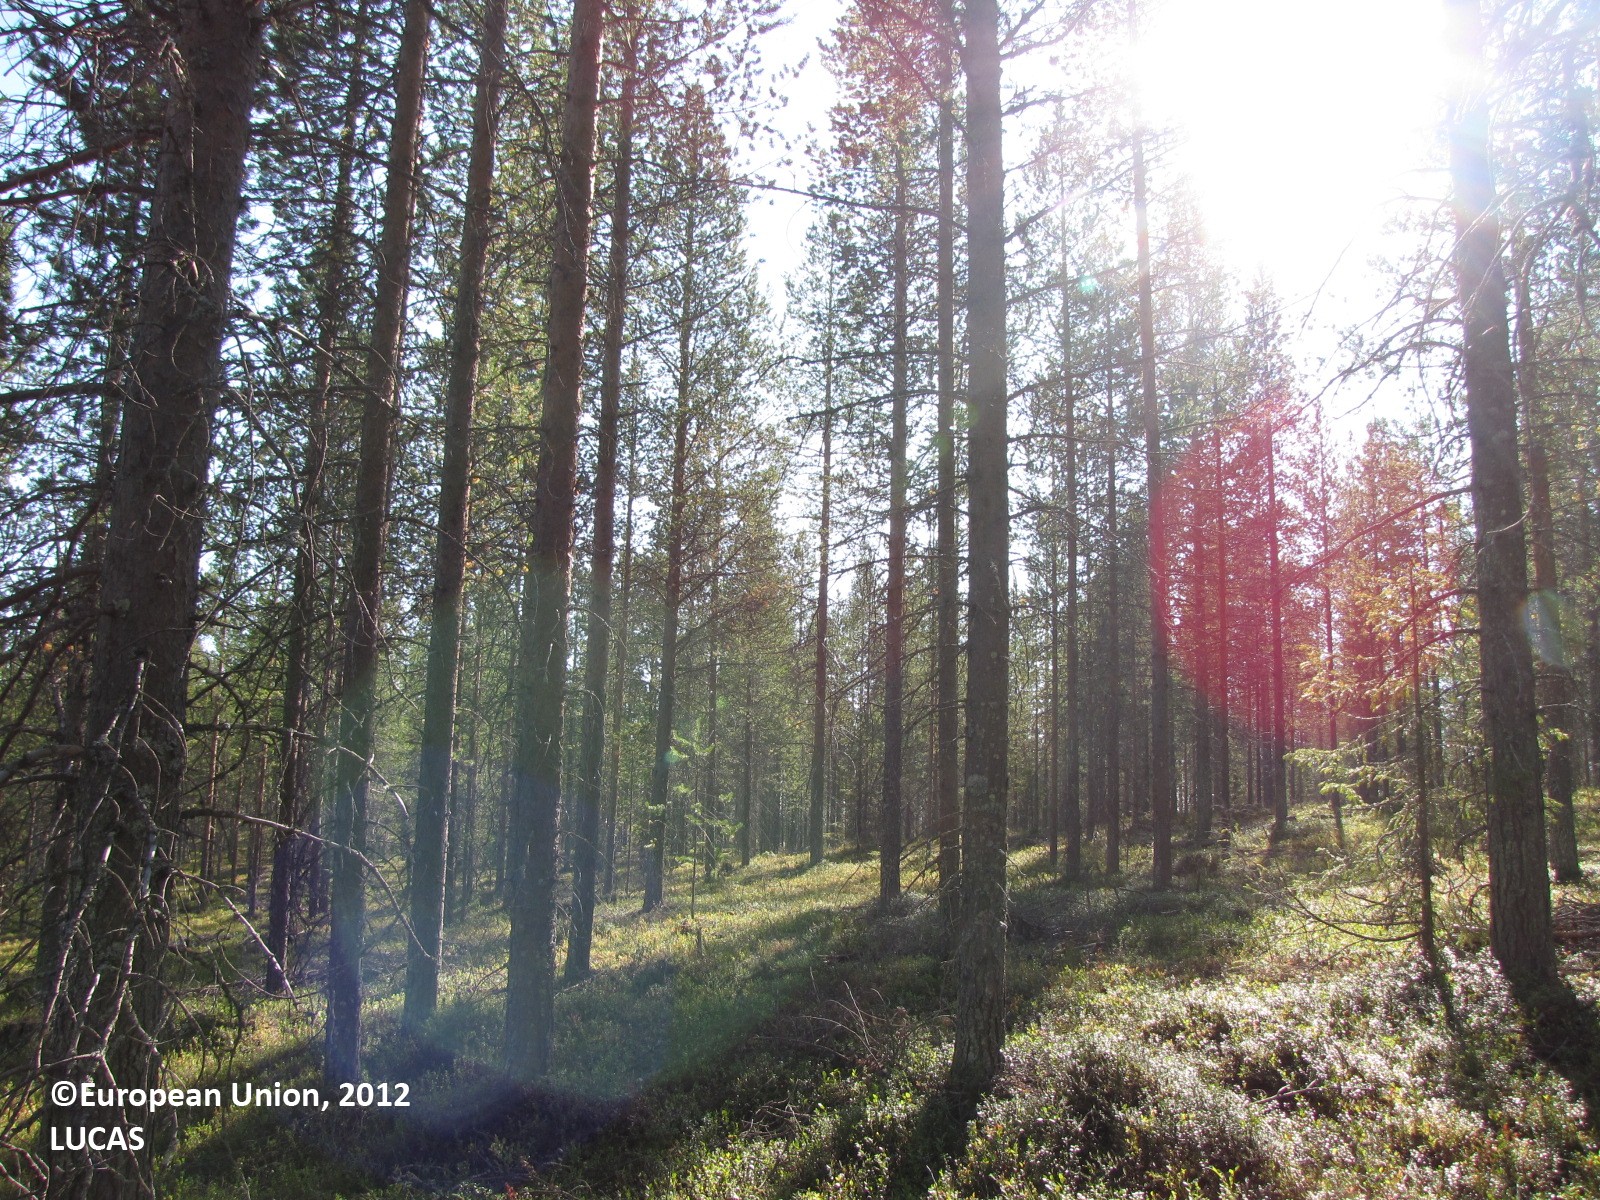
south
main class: Woodland
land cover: Pine dominated coniferous woodland
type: boreal forest
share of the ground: 25 - 50 %
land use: Forestry
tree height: > 5 m
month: August
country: FI
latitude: 67.0071
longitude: 25.2150
